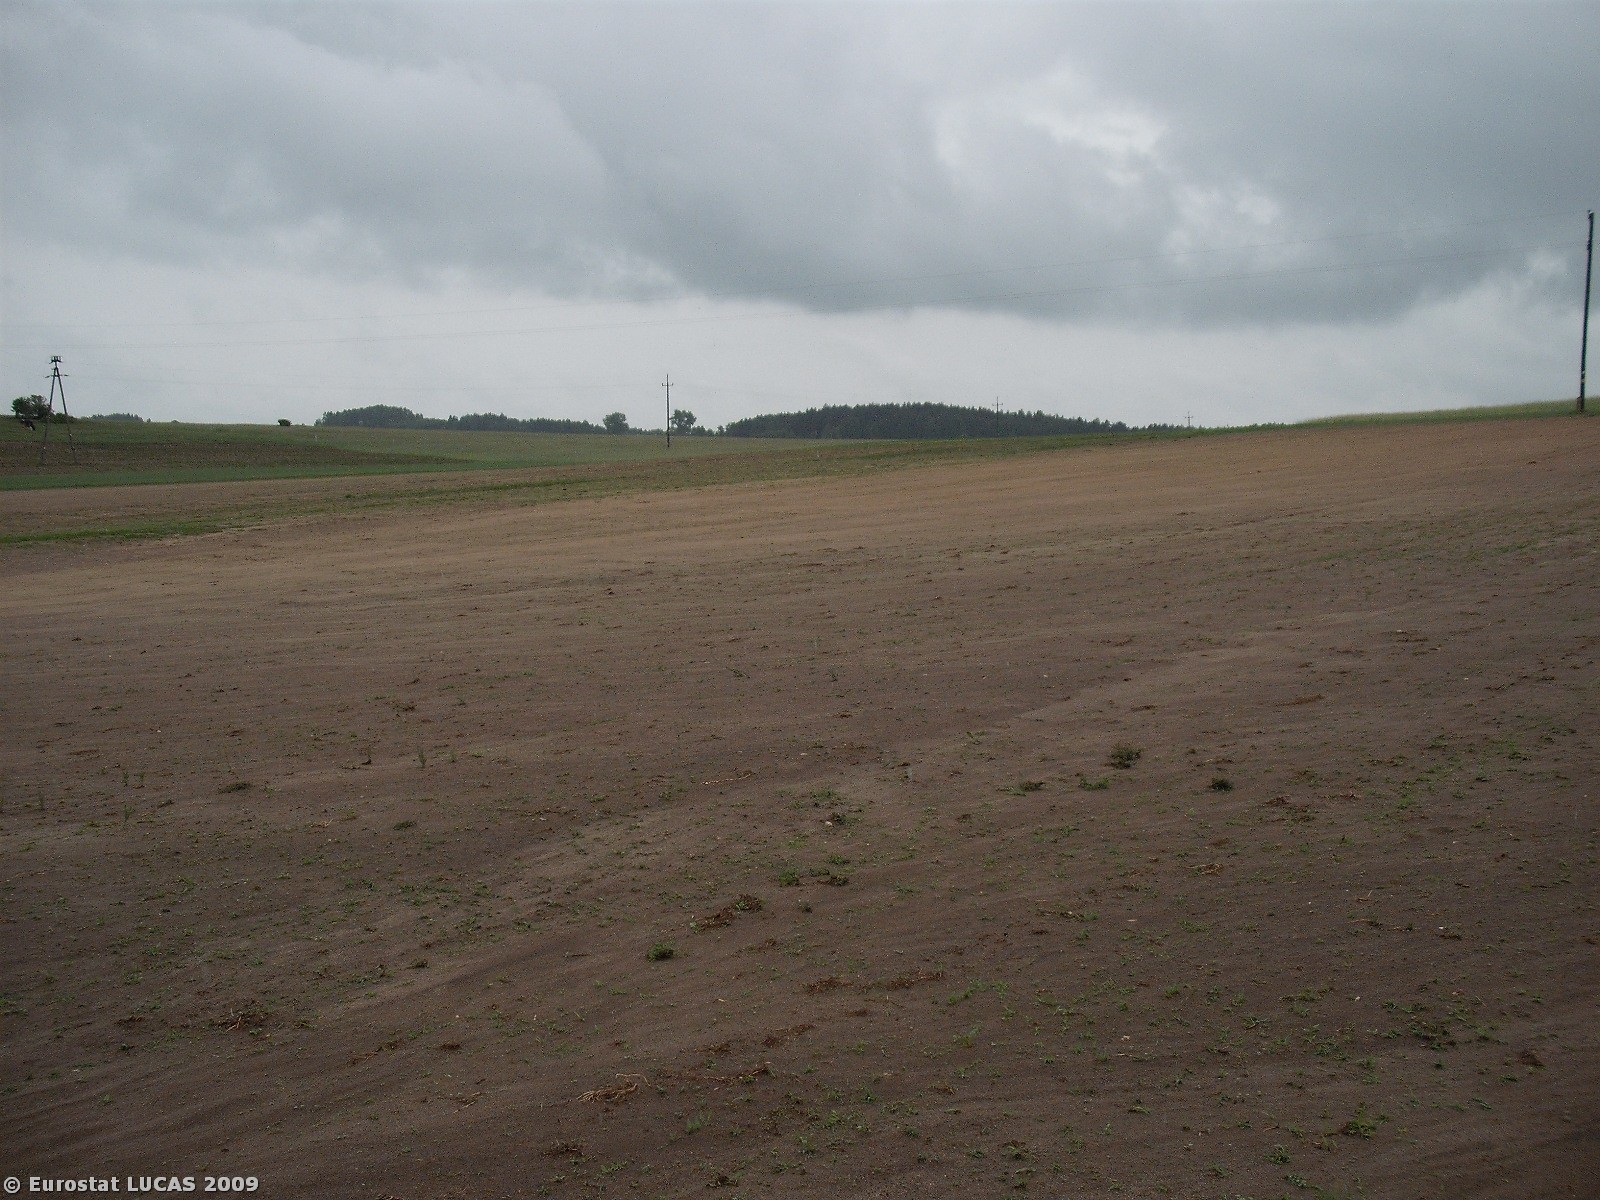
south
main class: Grassland
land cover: Grassland without tree/shrub cover
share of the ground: < 10 %
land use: Agriculture (excluding fallow land and kitchen gardens)
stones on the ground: < 10 %
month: May
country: PL
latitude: 51.0552
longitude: 19.9188
